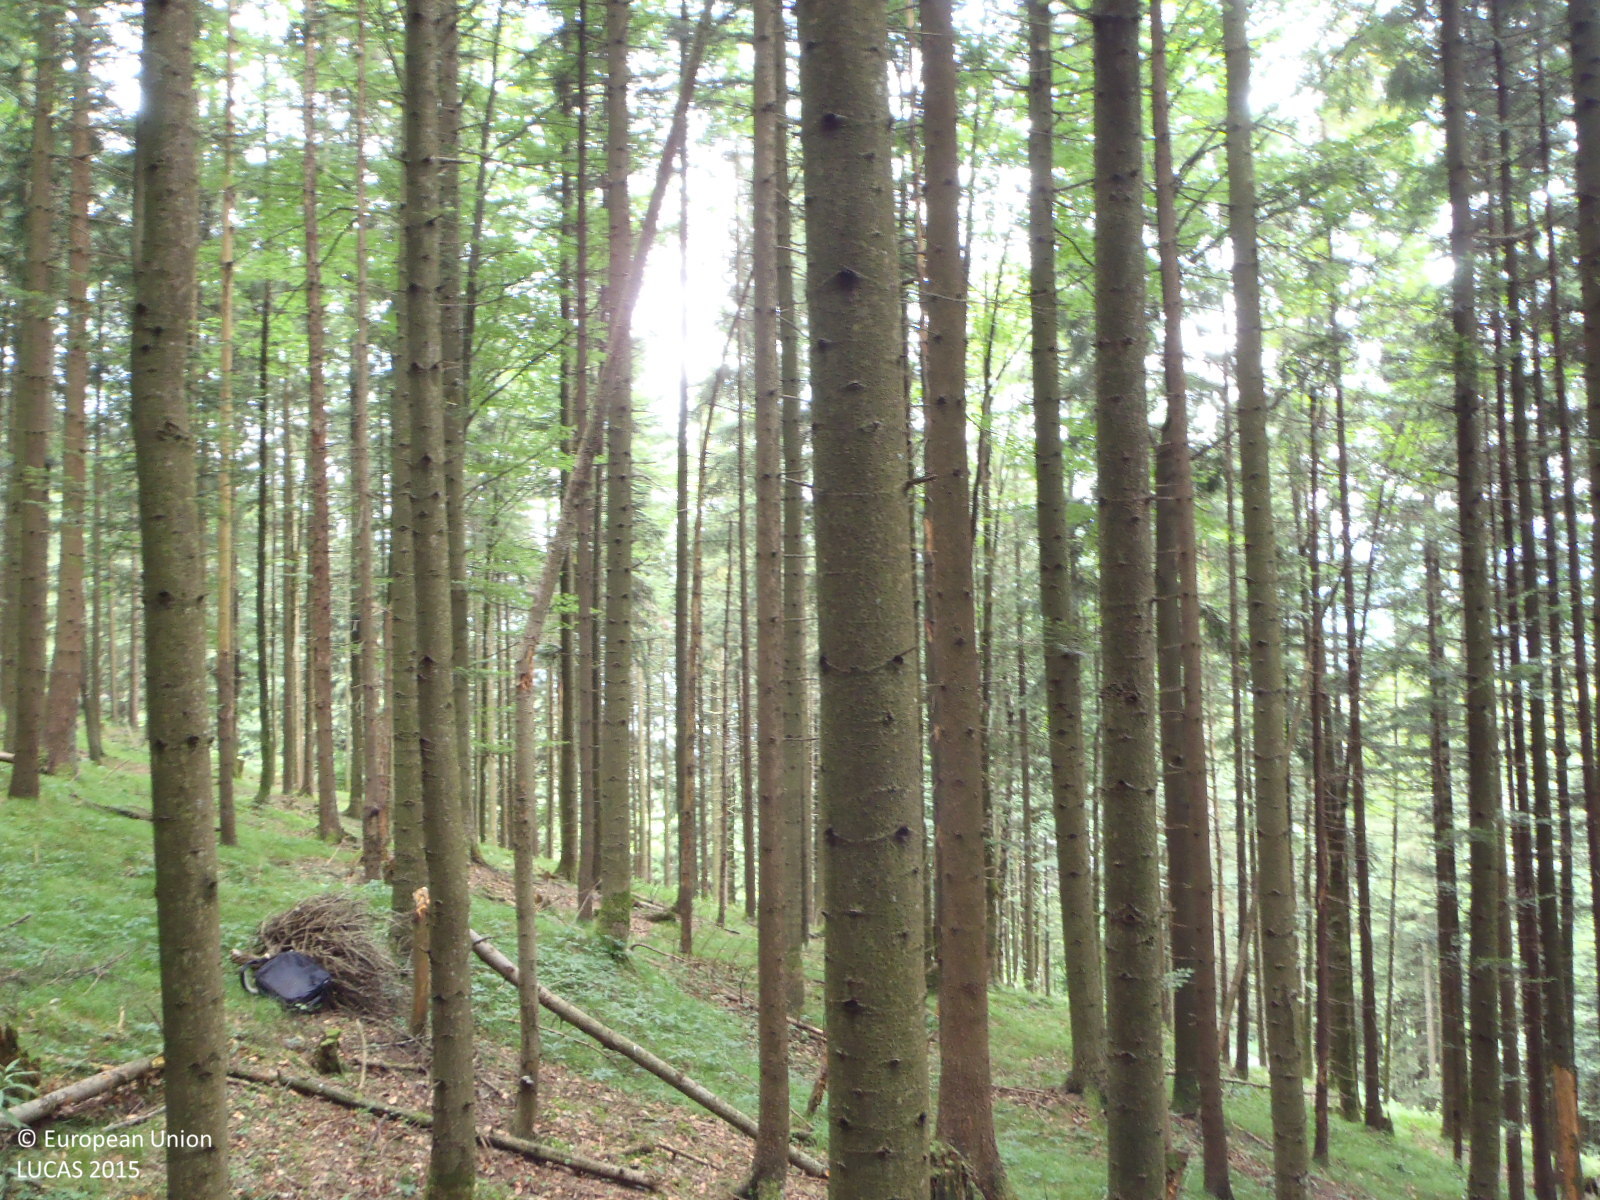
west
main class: Woodland
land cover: Spruce dominated coniferous woodland
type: alpine coniferous forest
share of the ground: > 75 %
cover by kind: coniferous forest trees 80 %, broadleaved forest trees 10 %, herbaceous plants 10 %
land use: Forestry
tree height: > 5 m
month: July
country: AT
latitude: 47.5896
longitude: 12.1926
